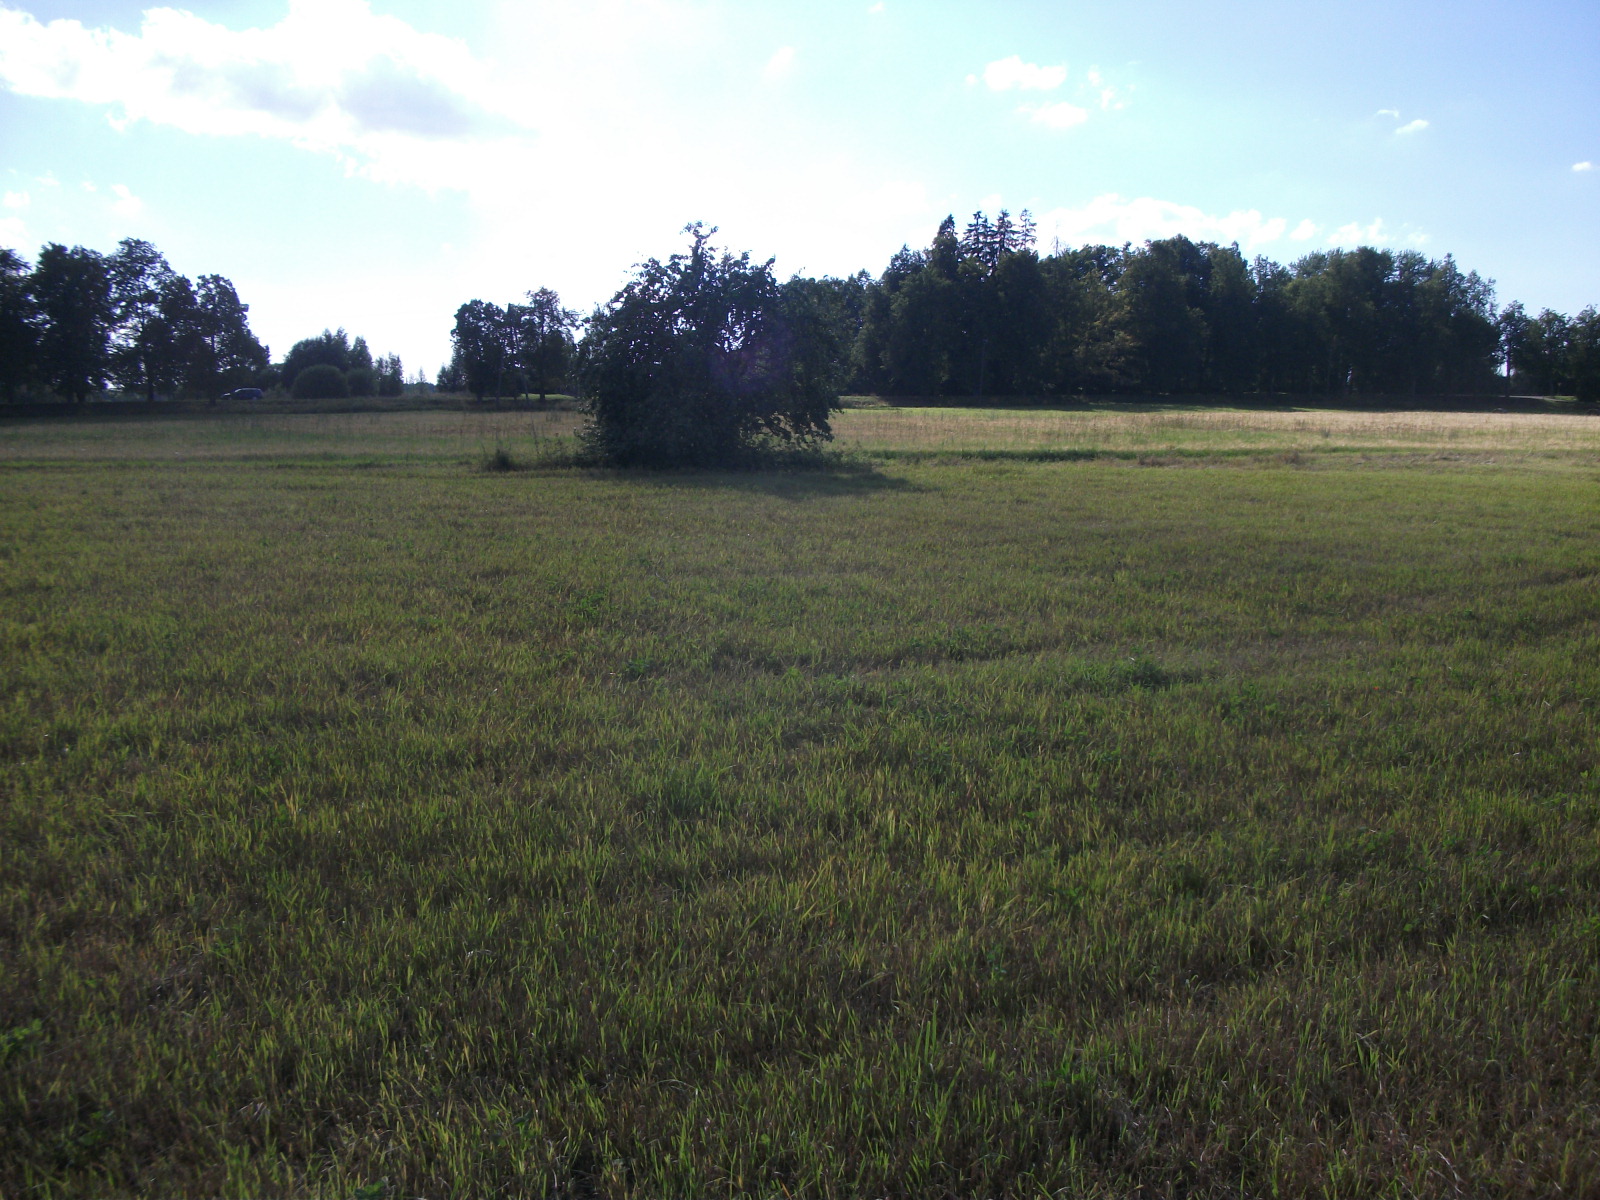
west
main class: Grassland
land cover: Grassland without tree/shrub cover
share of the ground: > 75 %
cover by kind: herbaceous plants 100 %
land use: Agriculture (excluding fallow land and kitchen gardens)
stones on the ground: < 10 %
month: August
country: LV
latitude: 57.0316
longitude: 26.5746
